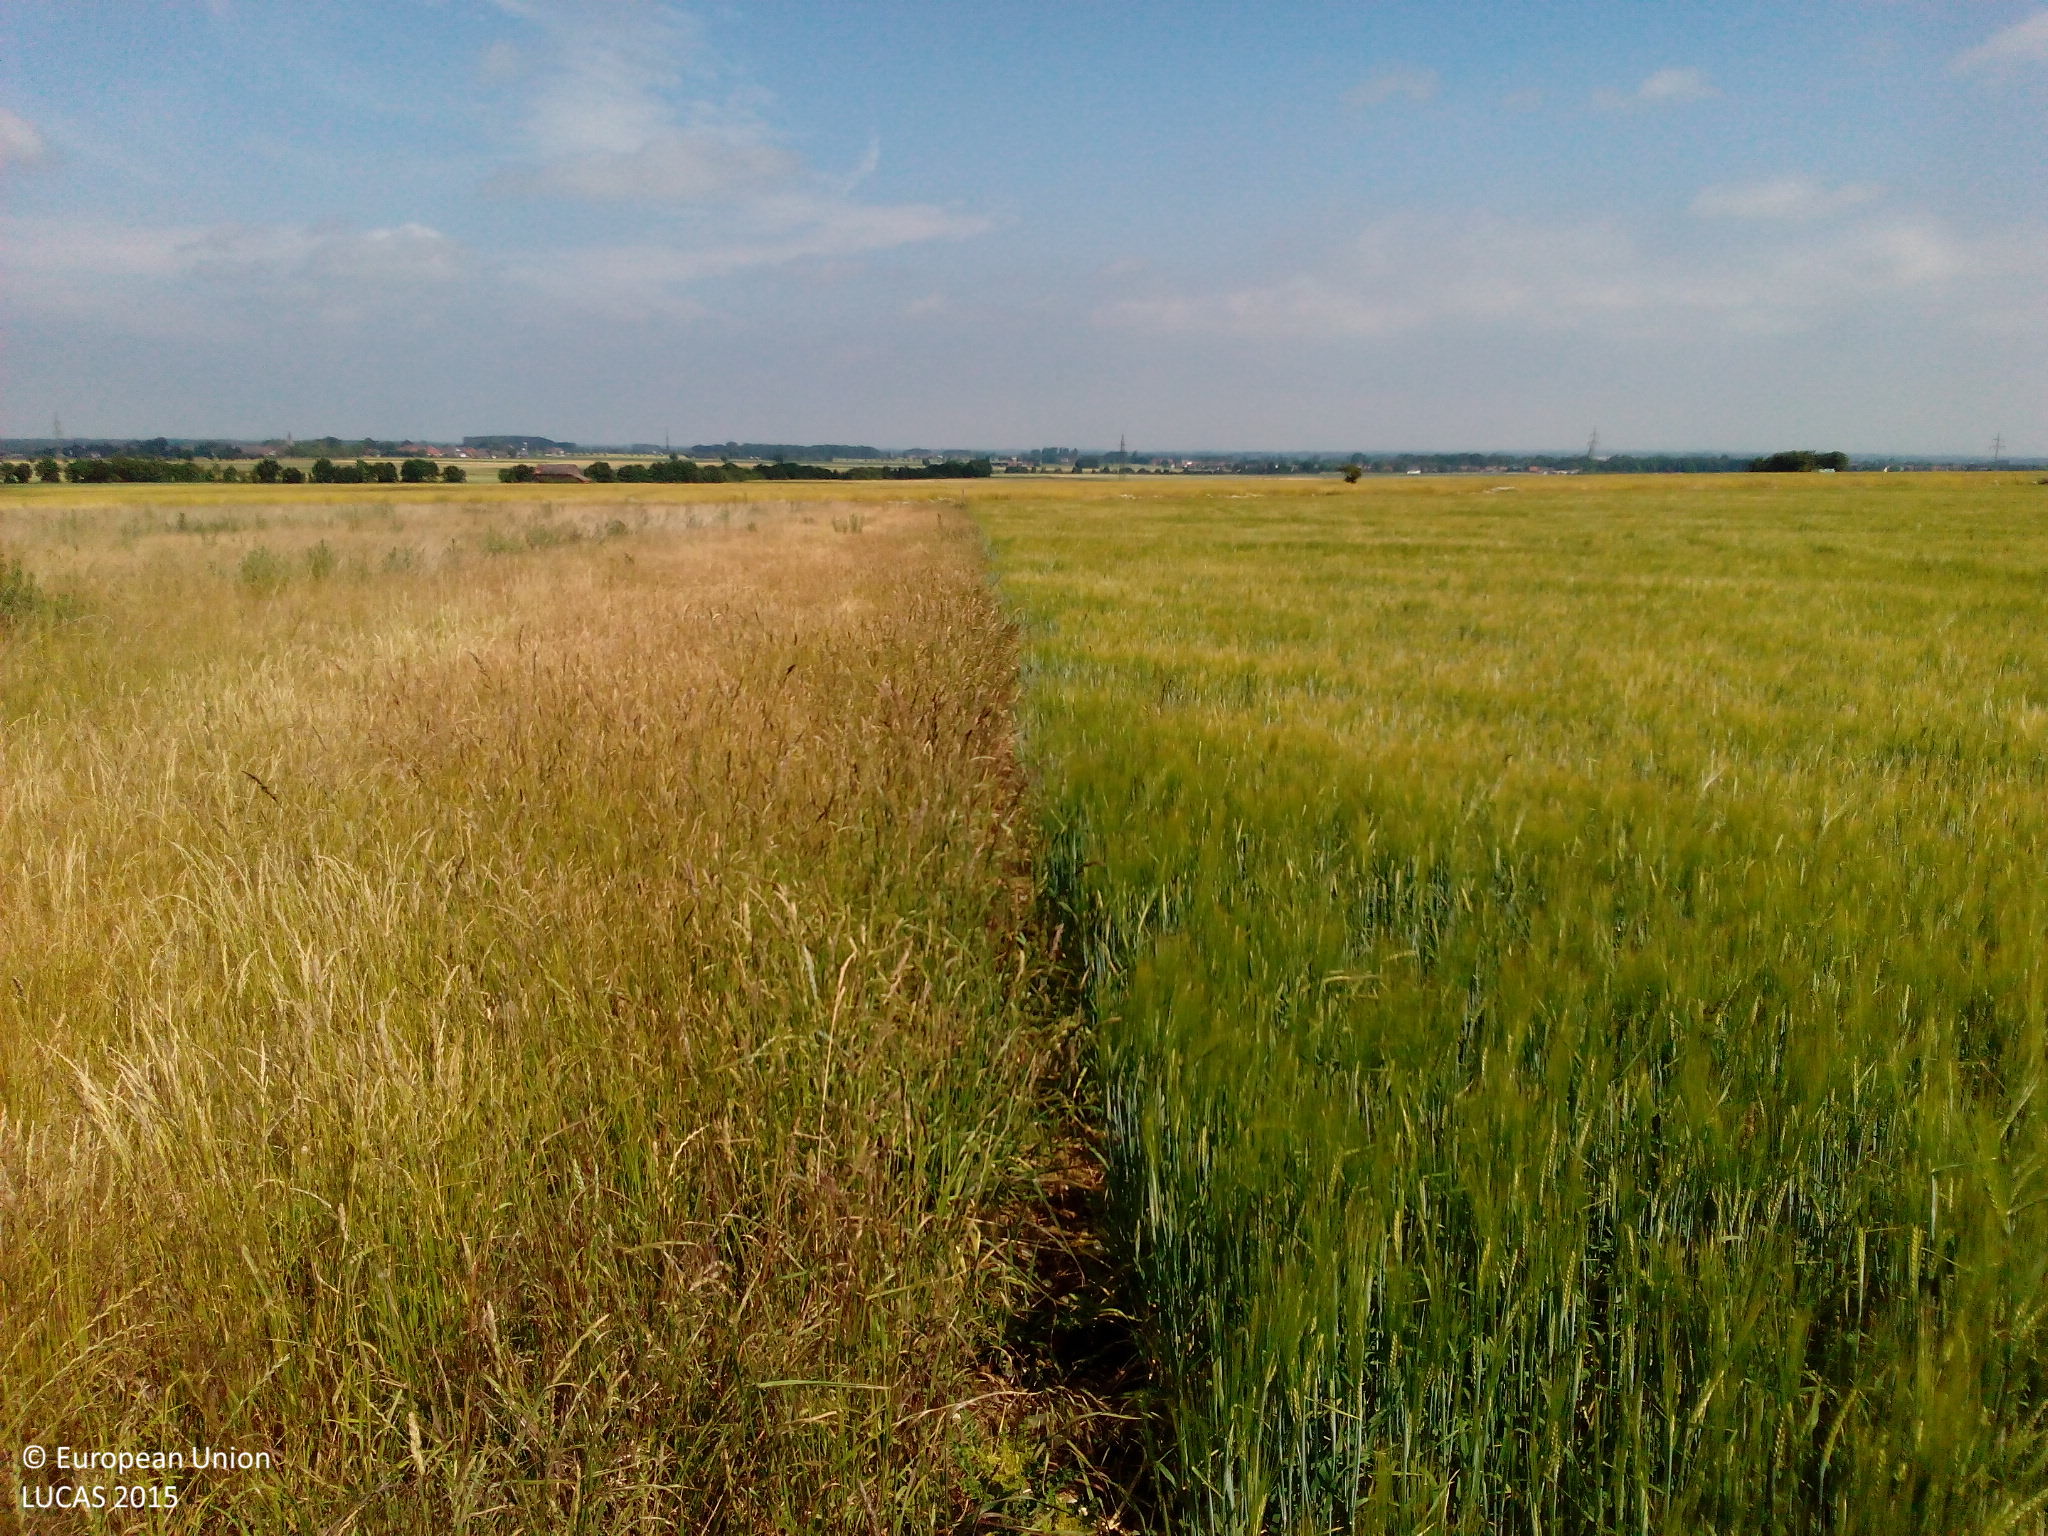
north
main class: Cropland
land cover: Barley
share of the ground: > 75 %
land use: Agriculture (excluding fallow land and kitchen gardens)
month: June
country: DE
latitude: 51.6123
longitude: 8.4552
